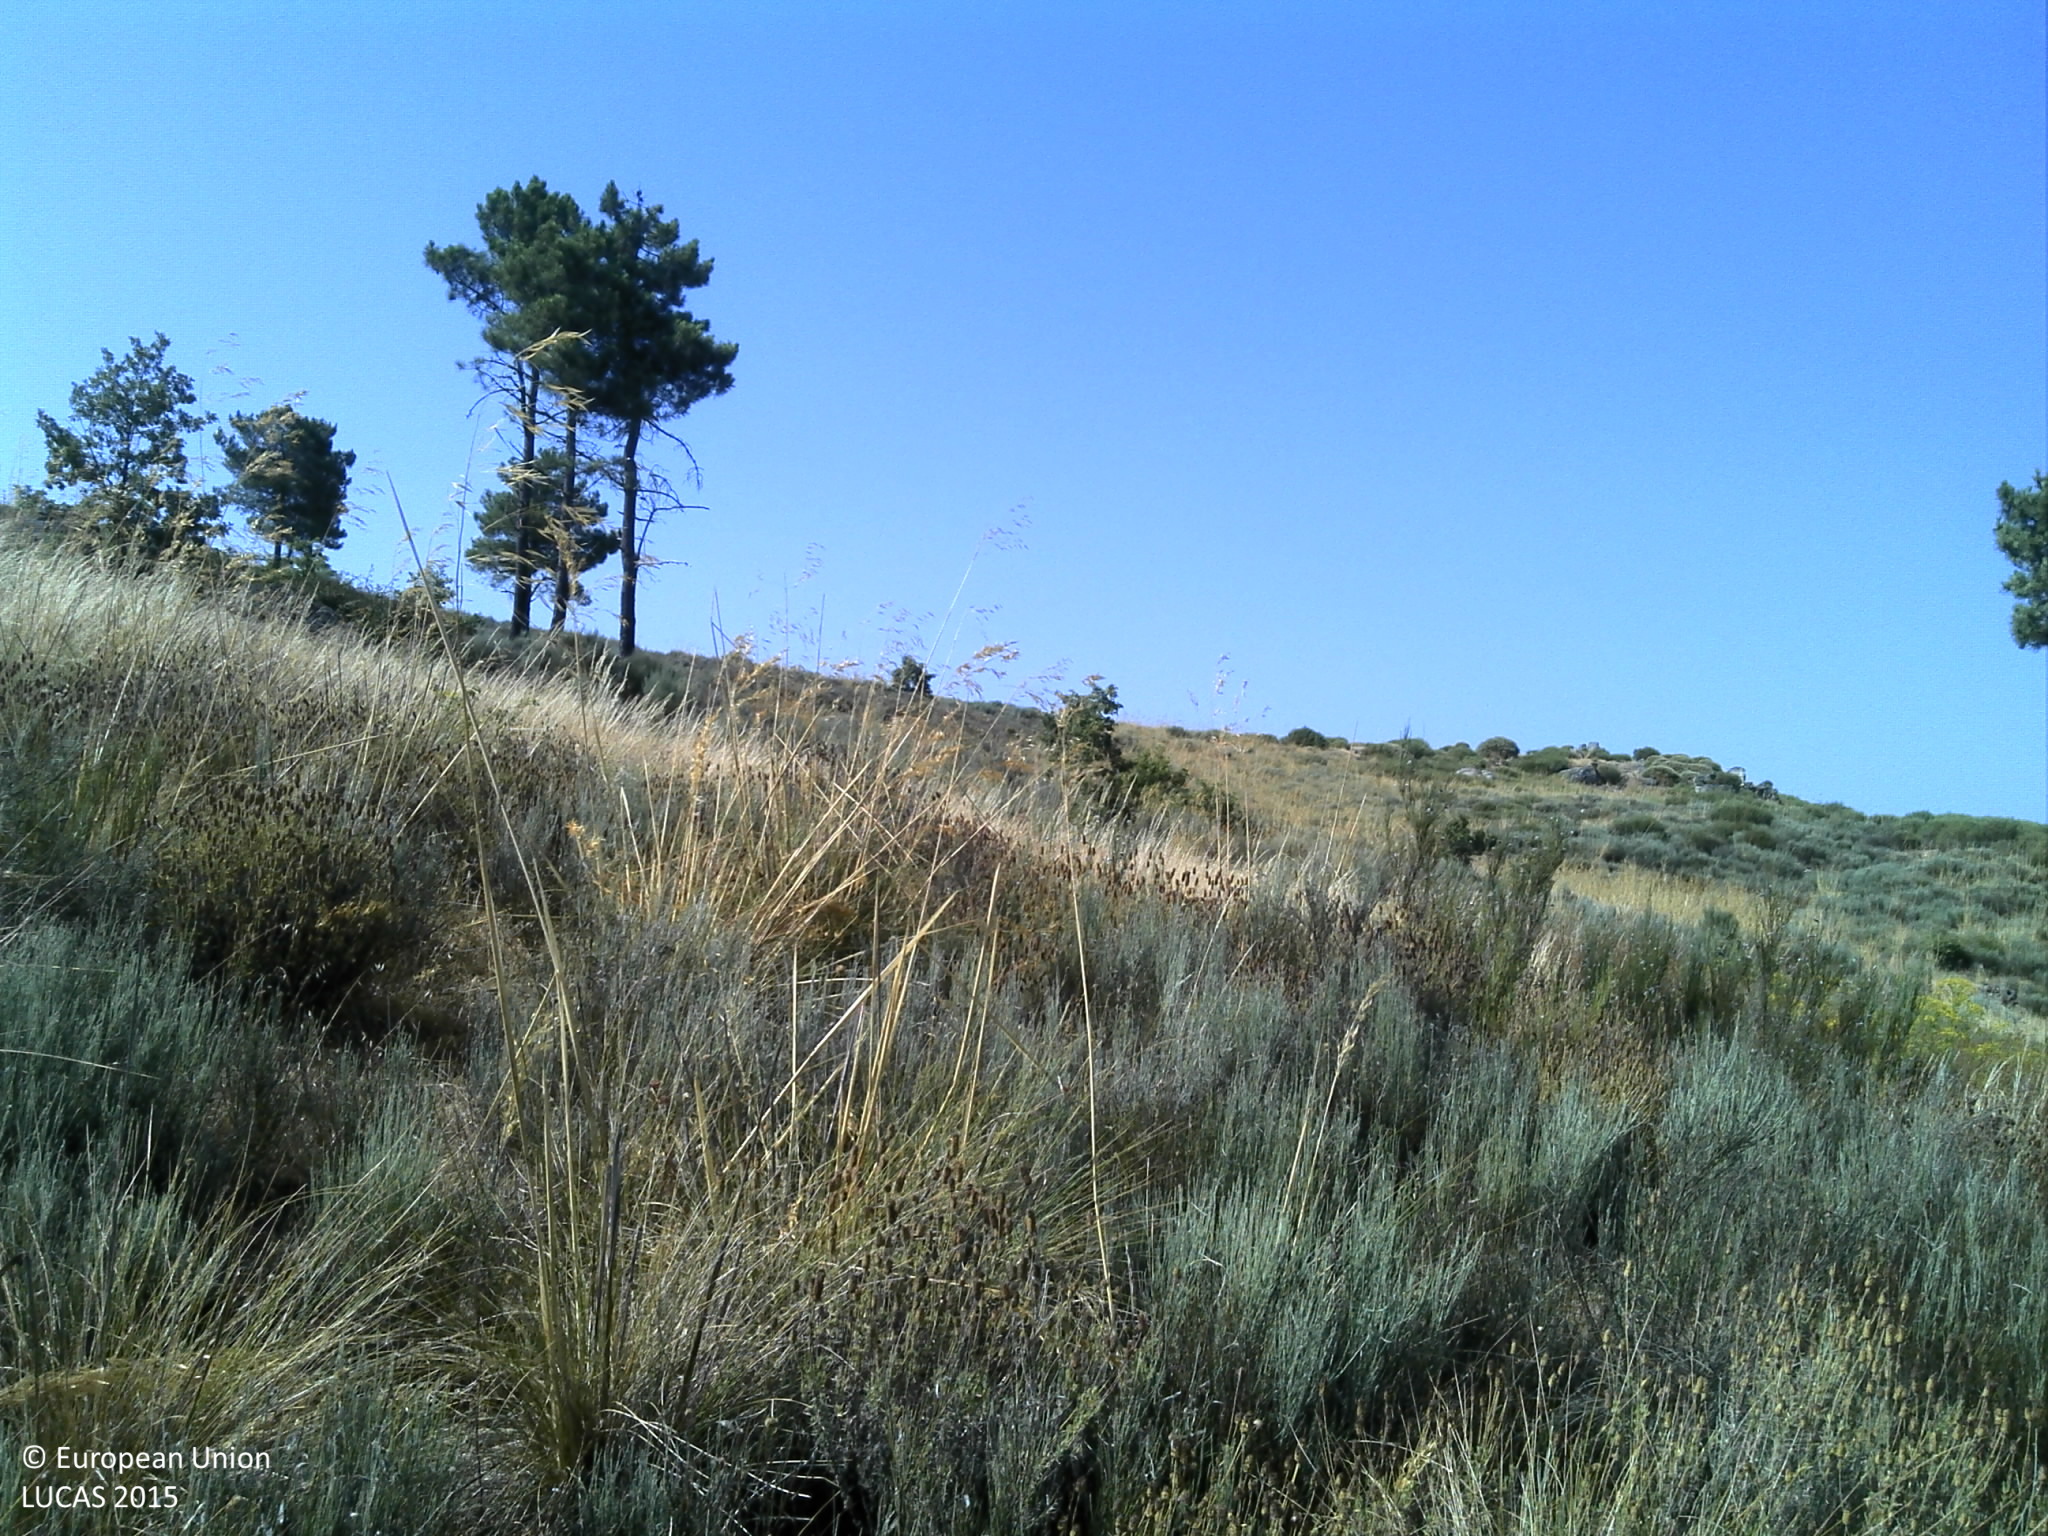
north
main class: Shrubland
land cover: Shrubland without tree cover
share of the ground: 25 - 50 %
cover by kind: shrubs 40 %, unconsolidated bare surface 30 %, consolidated bare surface 20 %, herbaceous plants 10 %
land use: Semi-natural and natural areas not in use
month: July
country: PT
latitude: 40.8744
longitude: -7.3061
